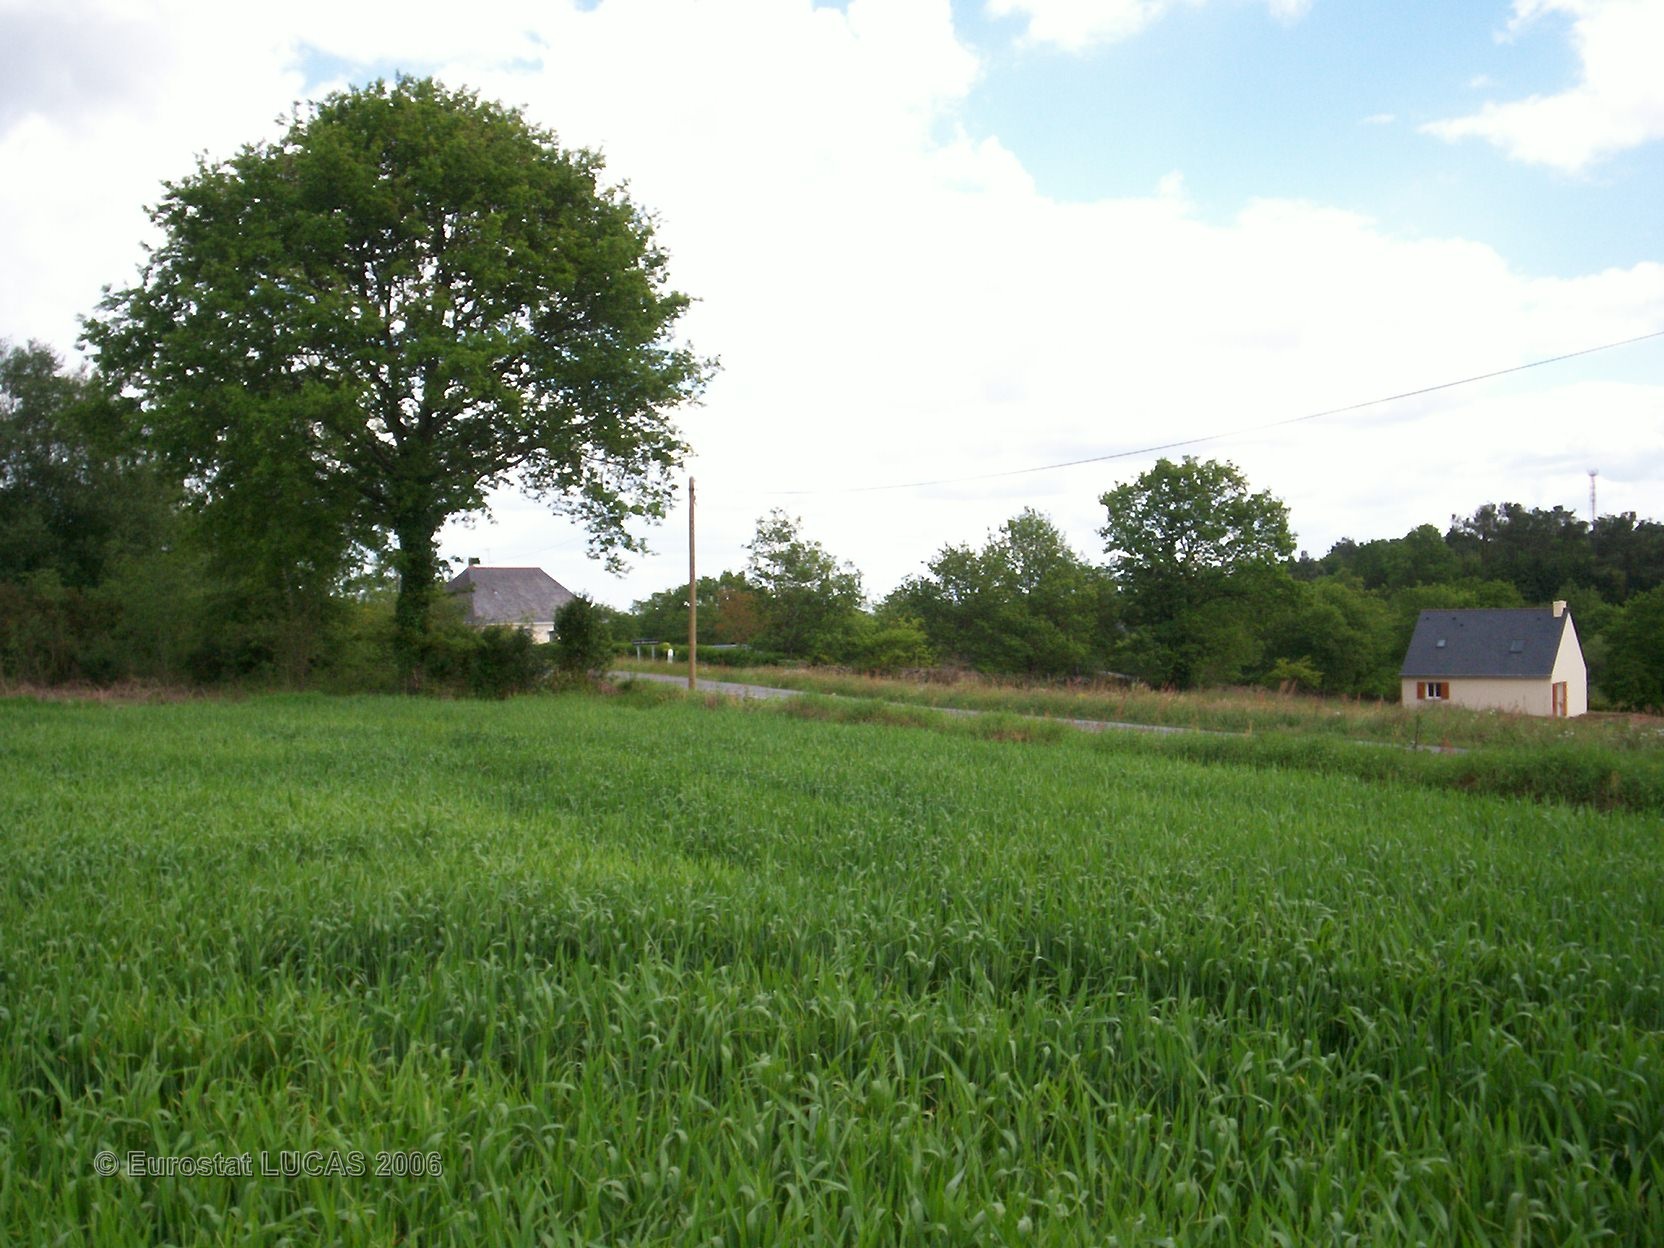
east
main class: Cropland
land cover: Common wheat
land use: Agriculture (excluding fallow land and kitchen gardens)
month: May
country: FR
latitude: 47.7415
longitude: -2.6908
